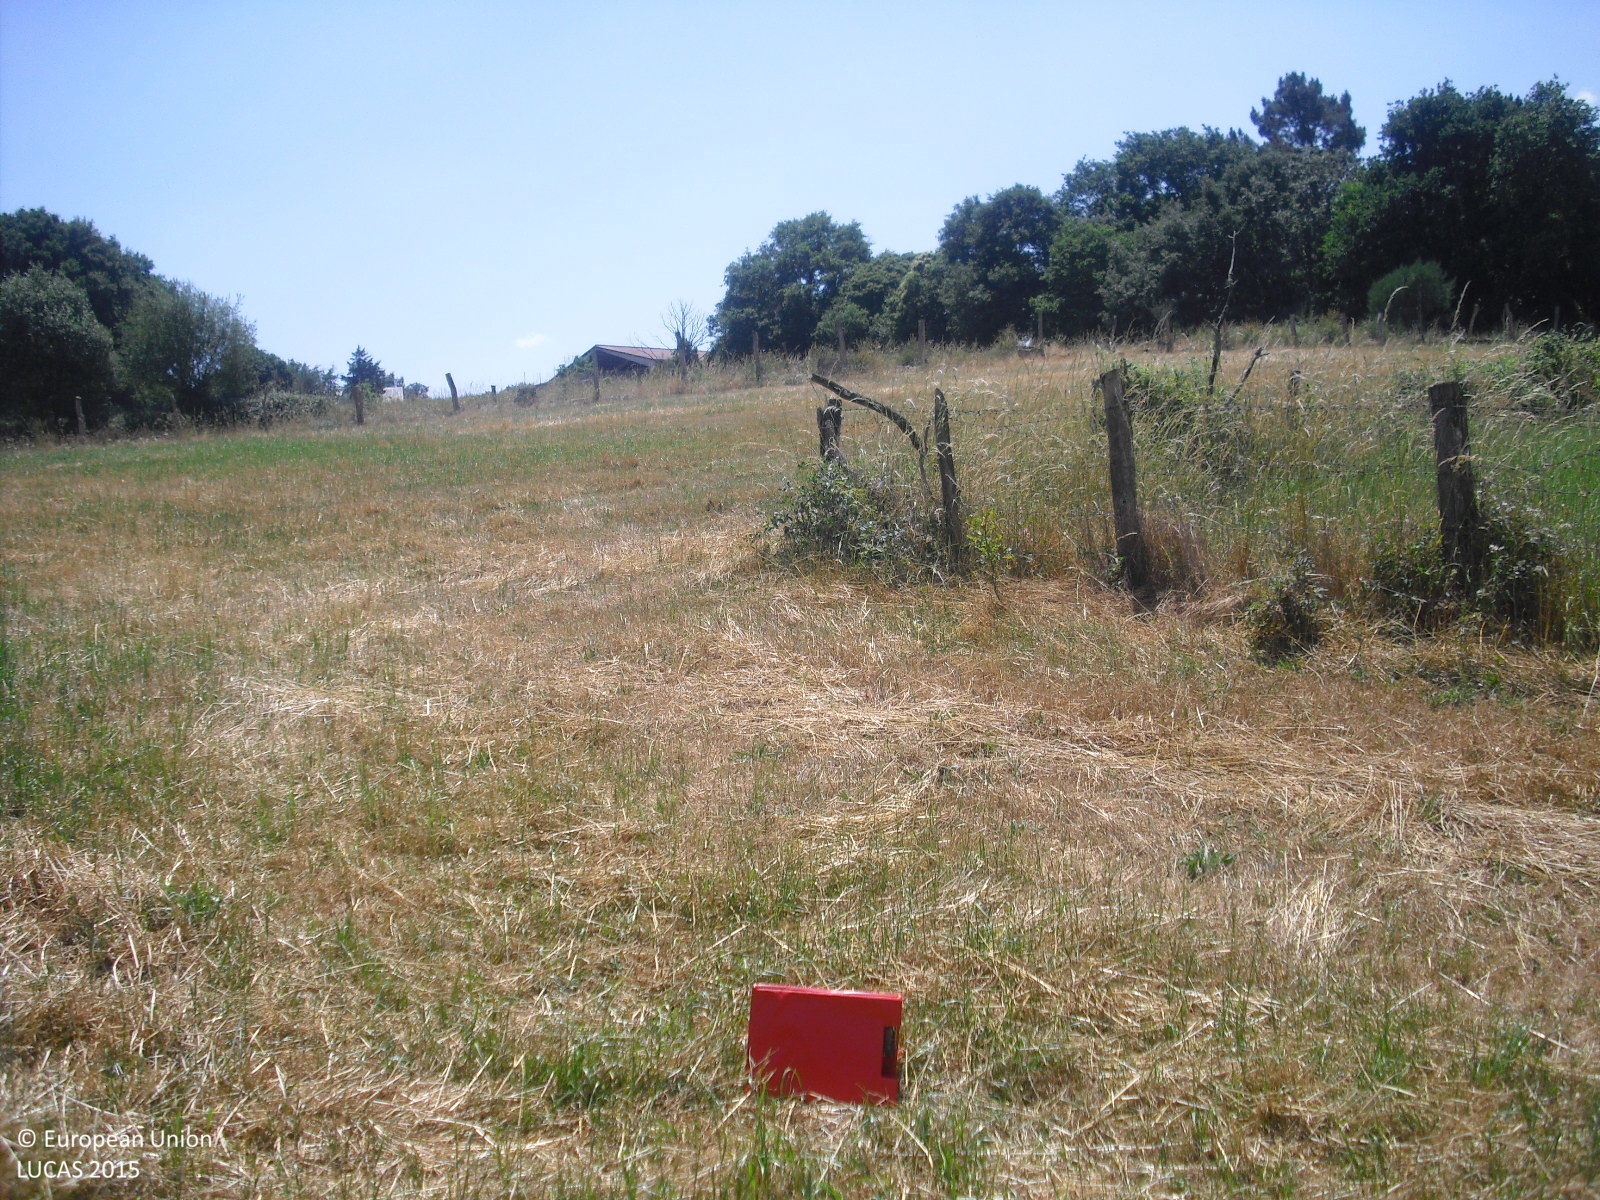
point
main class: Cropland
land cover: Temporary grasslands
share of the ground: > 75 %
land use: Agriculture (excluding fallow land and kitchen gardens)
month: June
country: ES
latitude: 42.6743
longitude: -7.7600
